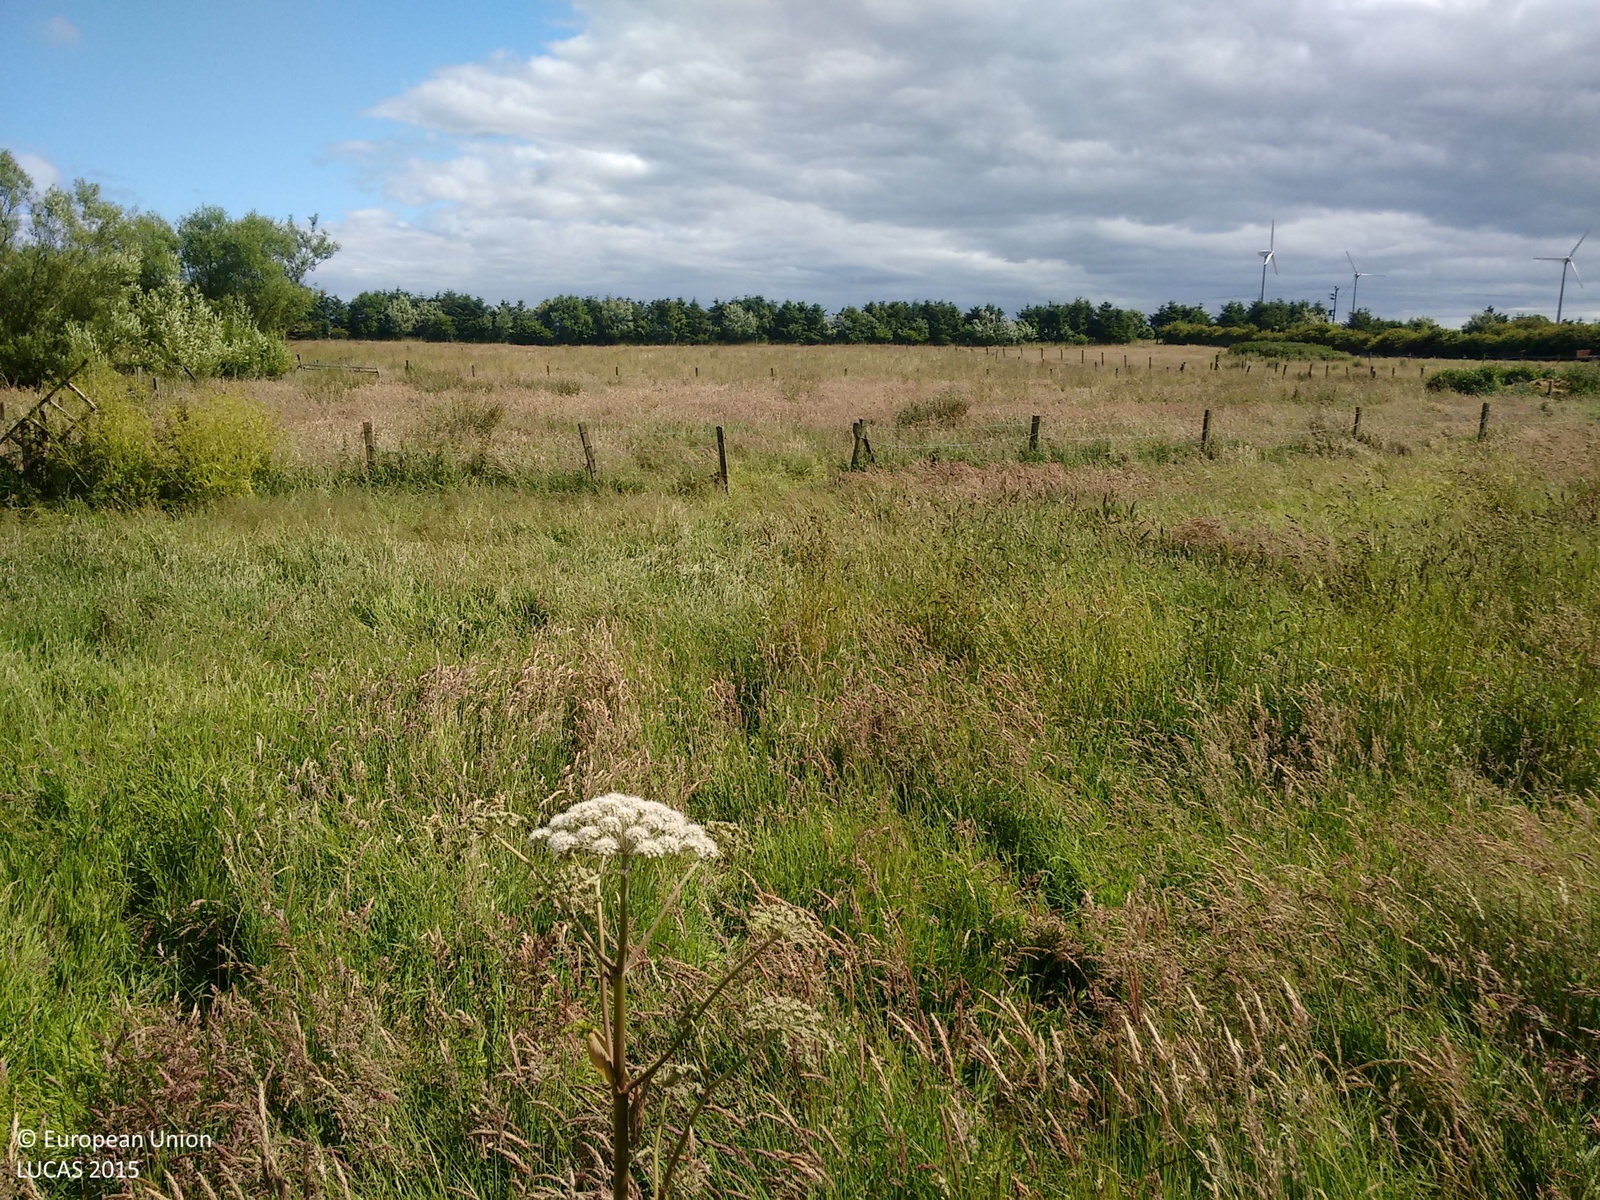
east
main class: Grassland
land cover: Grassland without tree/shrub cover
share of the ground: > 75 %
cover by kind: herbaceous plants 100 %
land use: Residential
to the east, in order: Grassland without tree/shrub cover; Fences; Grassland without tree/shrub cover; Fences; Grassland without tree/shrub cover; Managed hedges; Fences; Spruce dominated mixed woodland; Fences; Grass margins; Barley; Electric lines; Barley
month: July
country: GB
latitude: 57.5350
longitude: -1.9875
